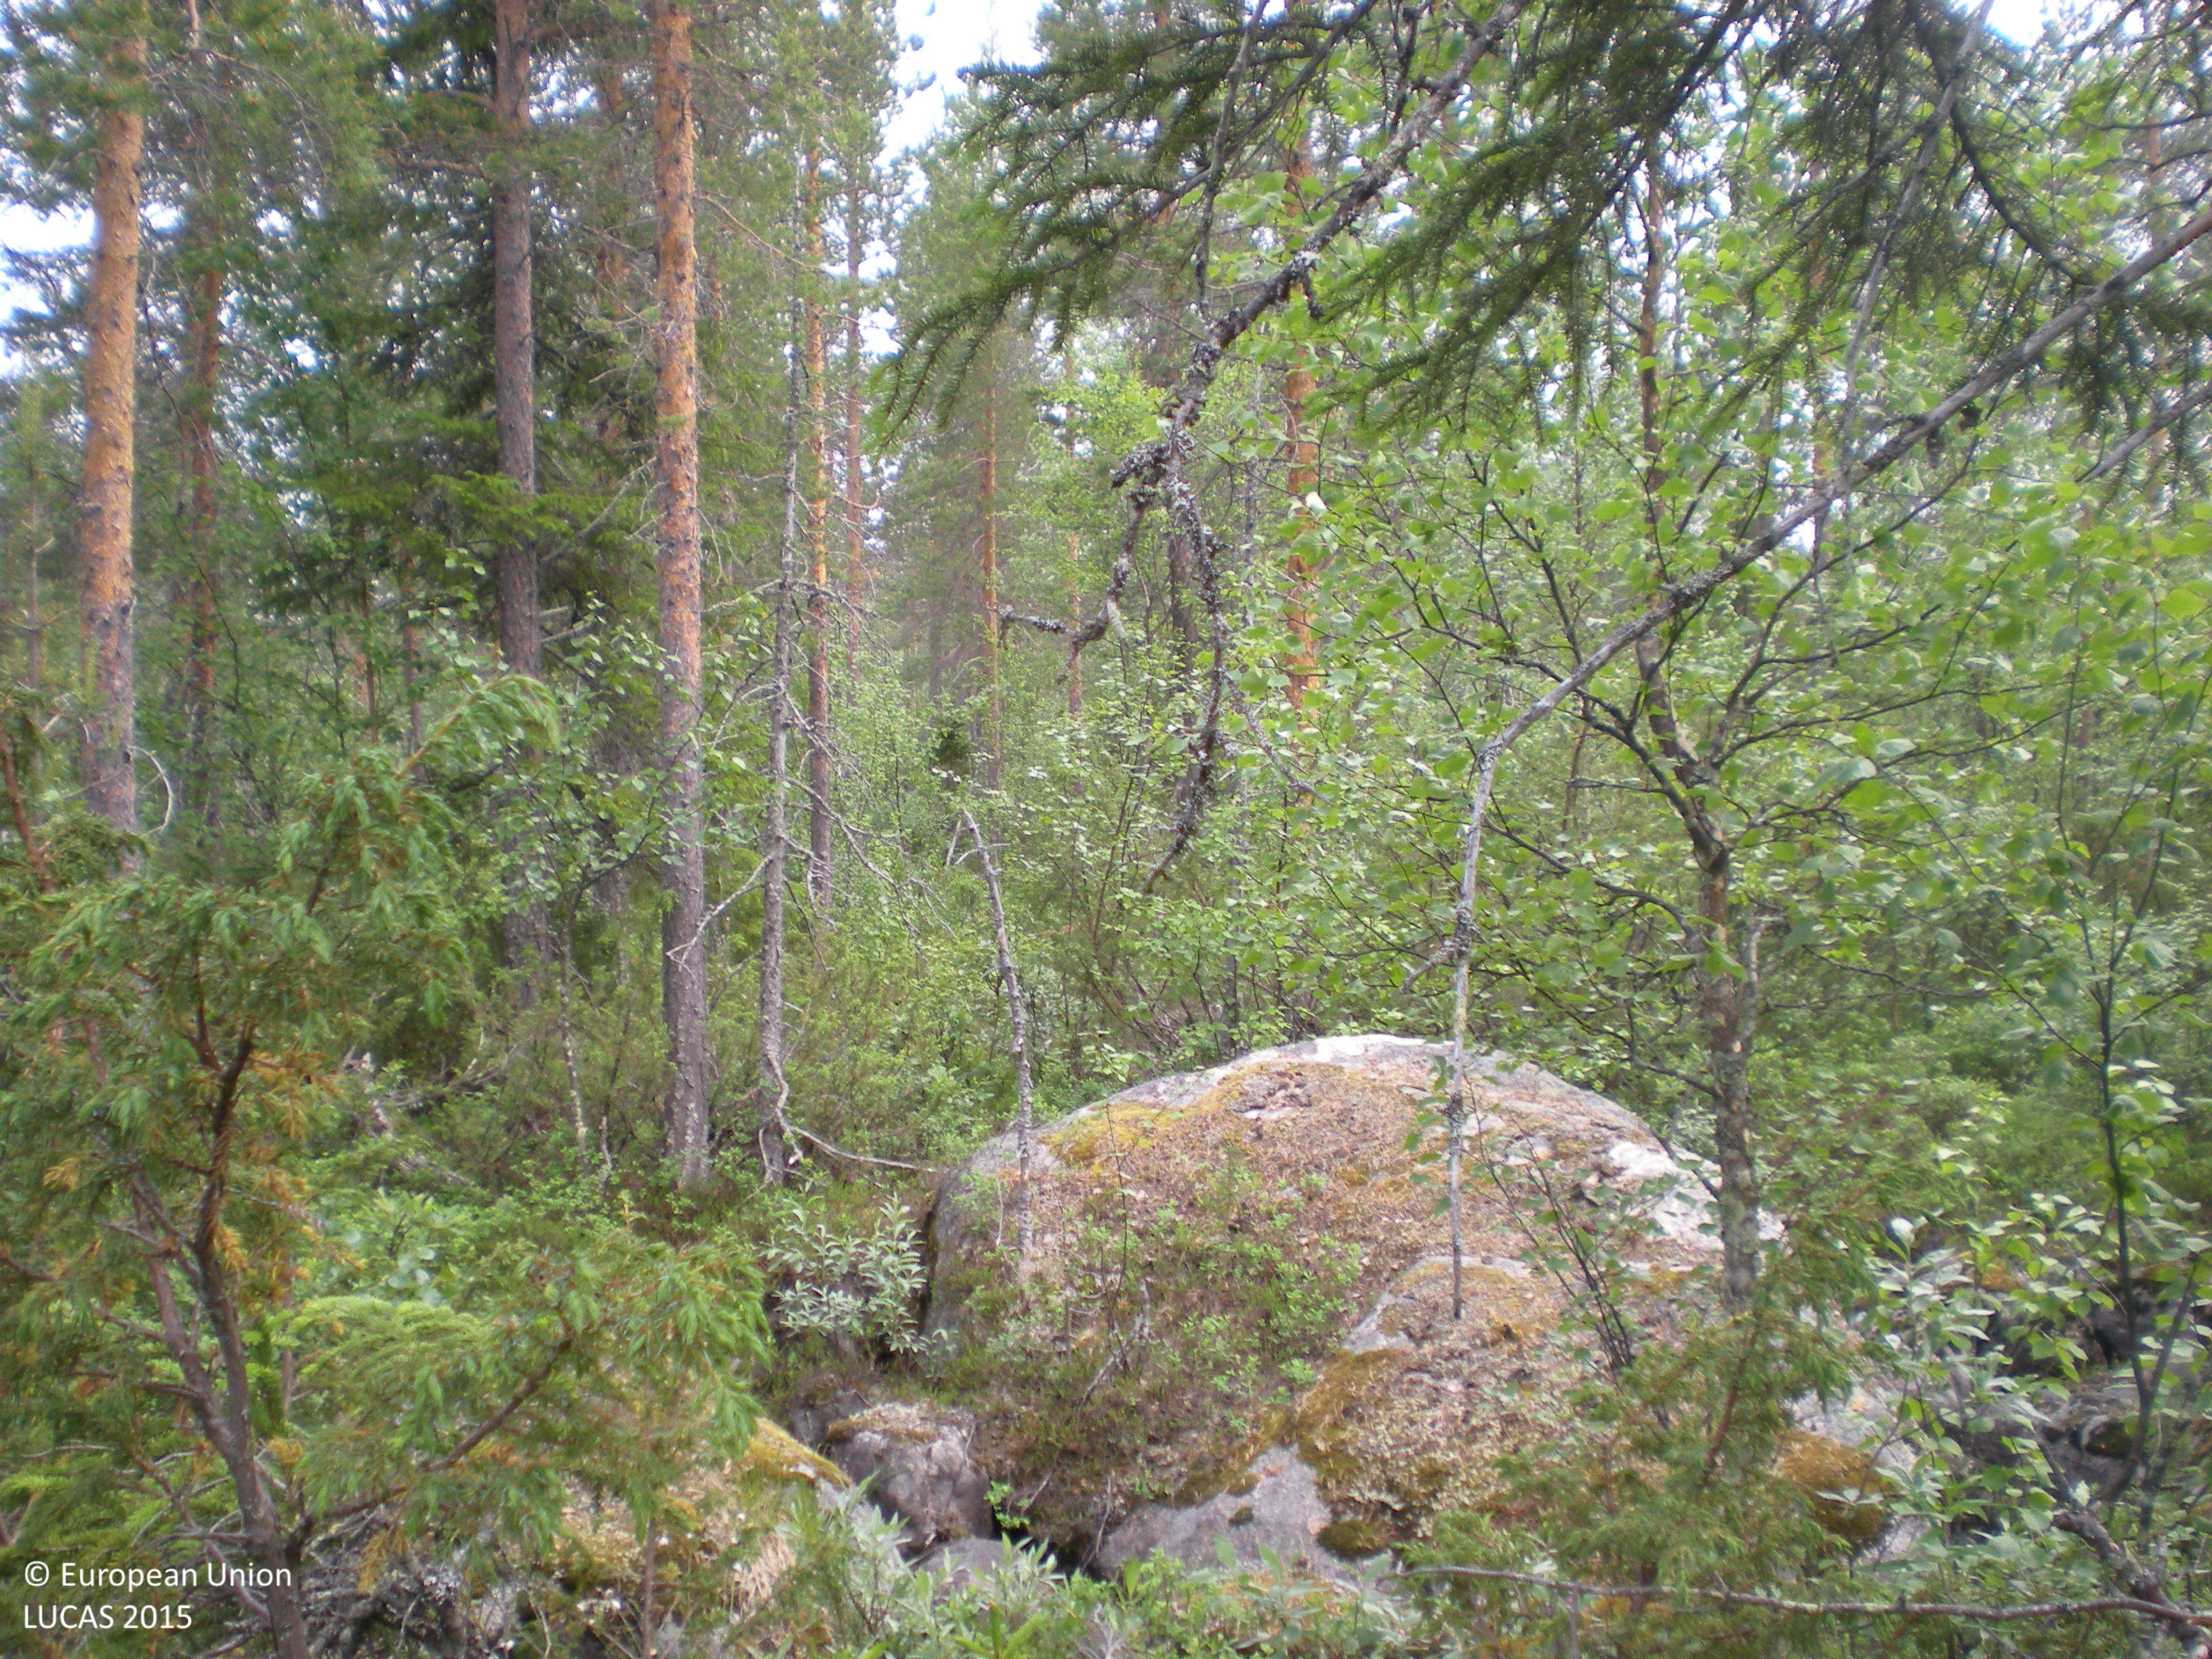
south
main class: Woodland
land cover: Pine dominated mixed woodland
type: boreal forest
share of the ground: 50 - 75 %
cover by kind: coniferous forest trees 40 %, broadleaved forest trees 20 %, shrubs 20 %, lichens and mosses 10 %, herbaceous plants 5 %, consolidated bare surface 5 %
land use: Forestry
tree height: > 5 m
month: July
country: SE
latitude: 65.4520
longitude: 17.9632
